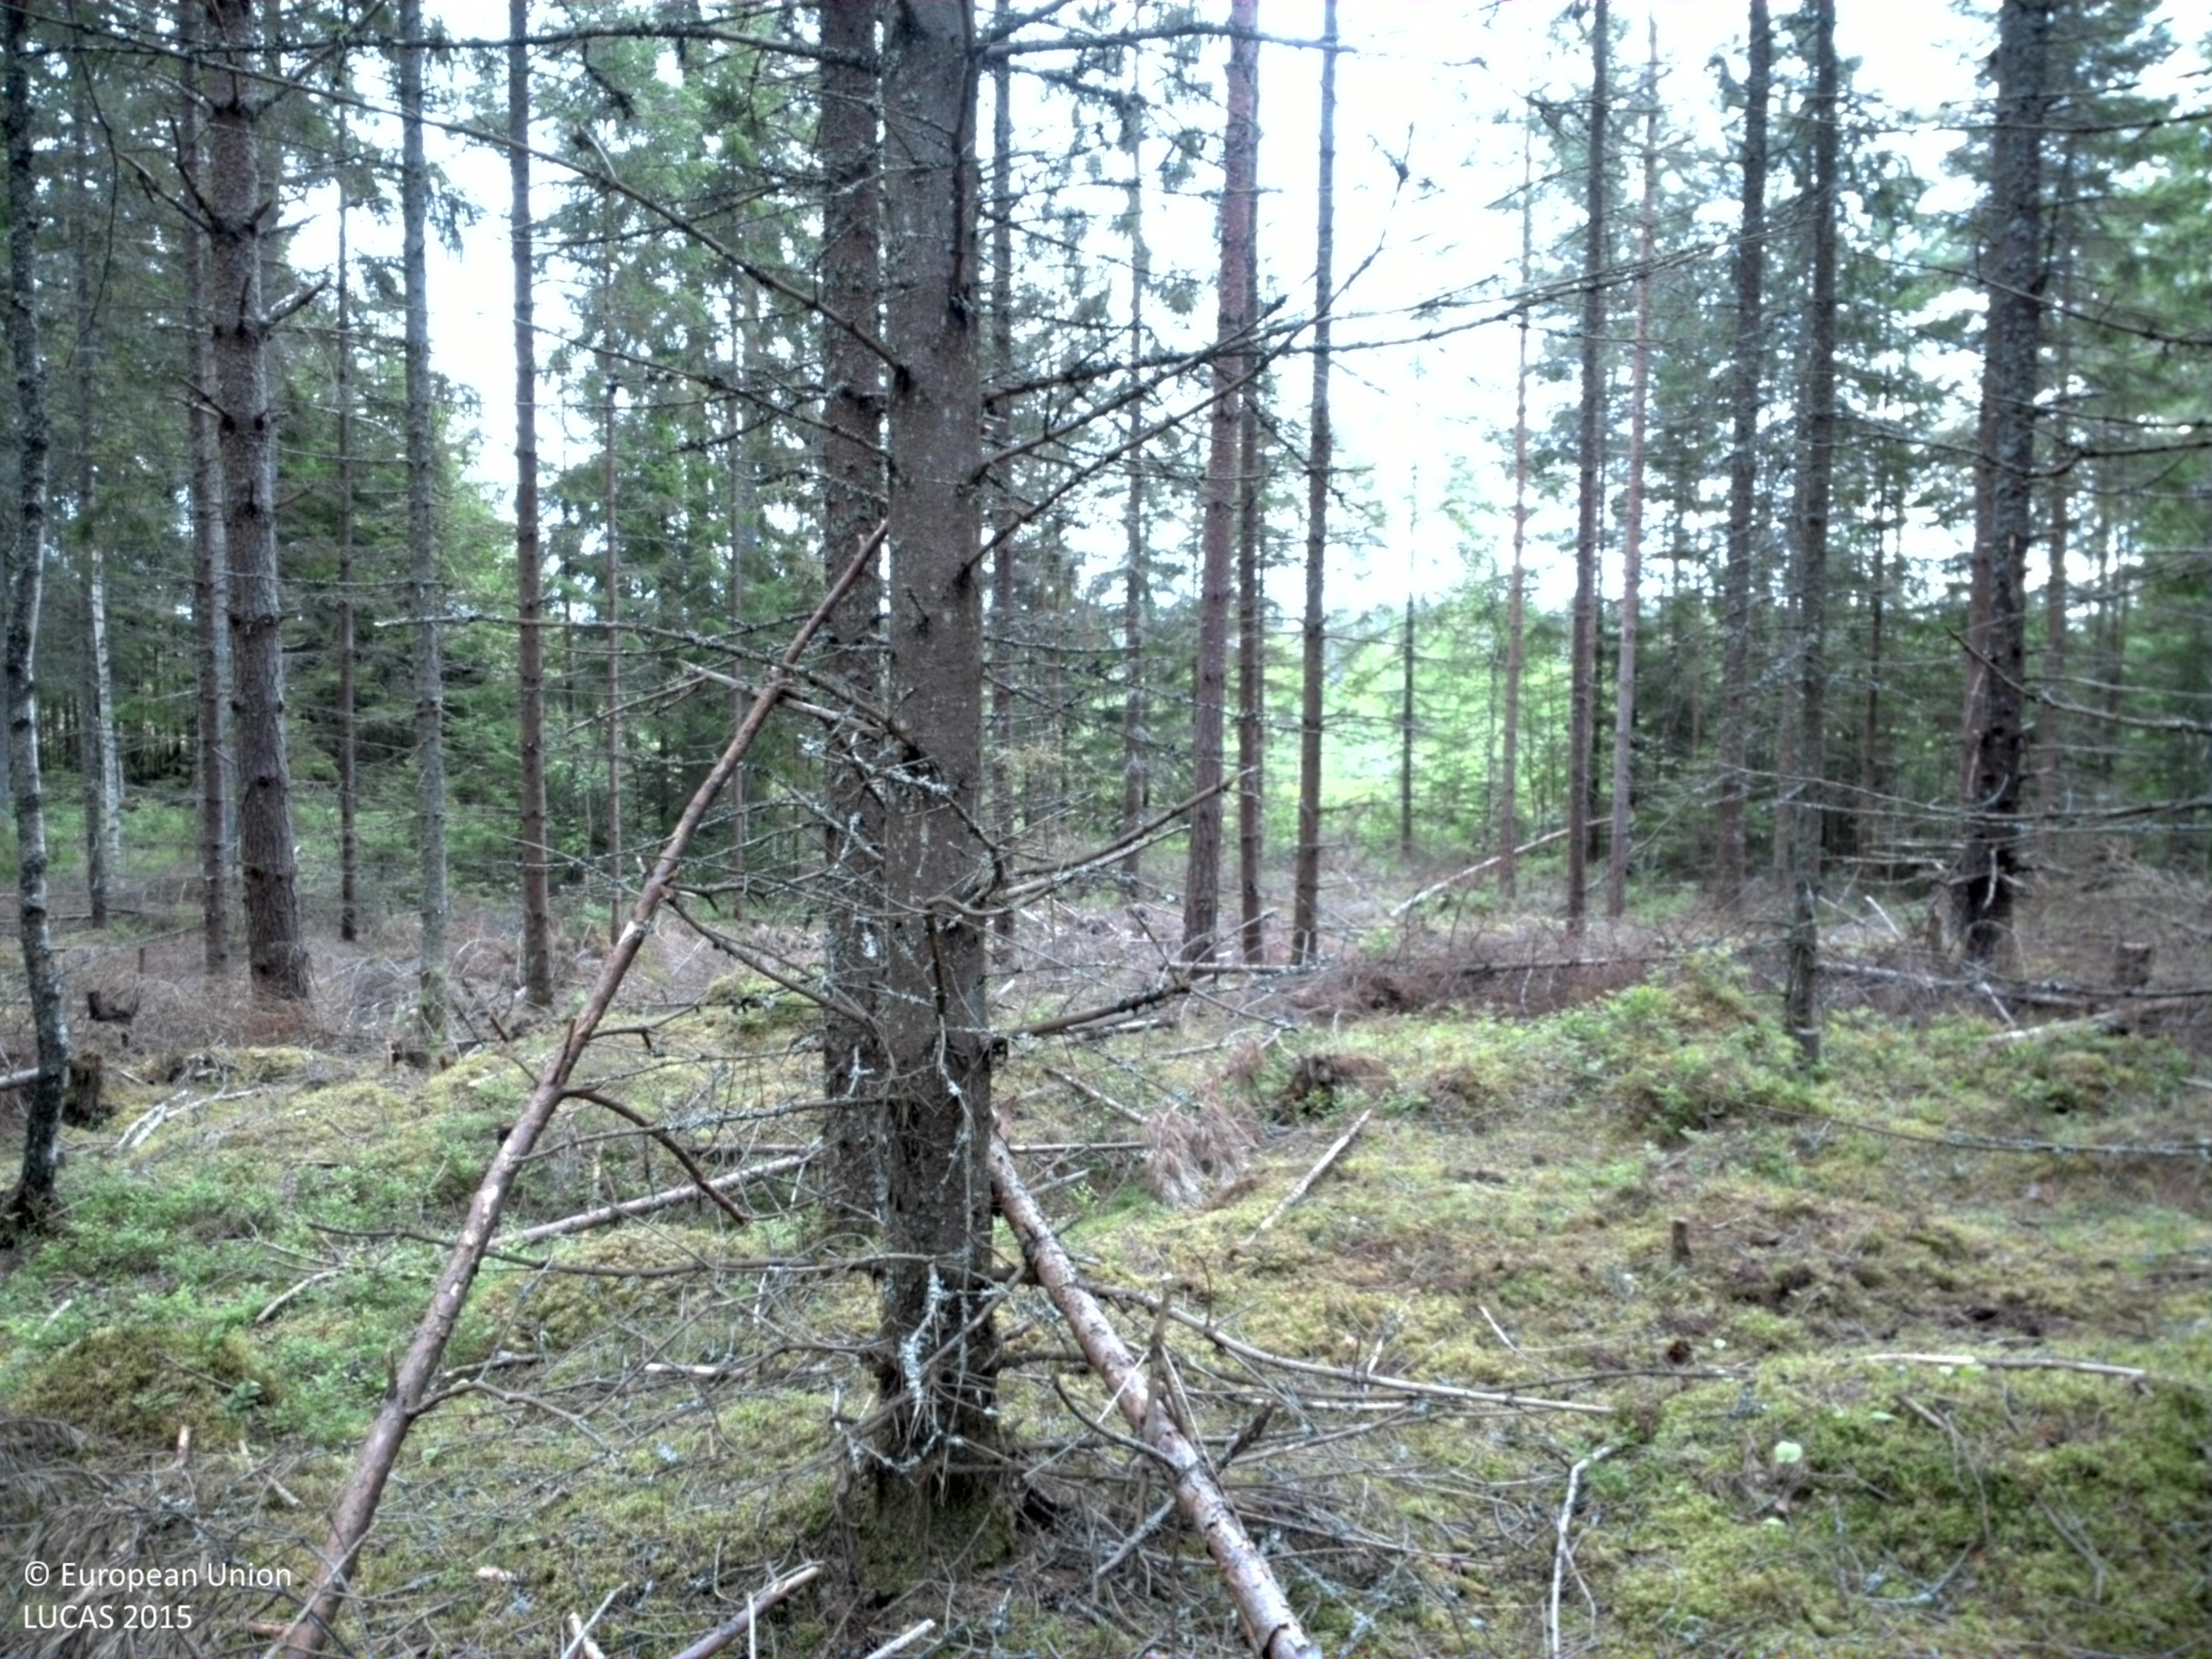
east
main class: Woodland
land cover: Spruce dominated coniferous woodland
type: boreal forest
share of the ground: 25 - 50 %
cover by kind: lichens and mosses 50 %, coniferous forest trees 45 %, herbaceous plants 5 %
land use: Forestry
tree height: > 5 m
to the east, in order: Spruce dominated coniferous woodland; Other coniferous woodland; Other mixed woodland; Ditches and canals; Other mixed woodland; Tracks; Other mixed woodland
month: July
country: SE
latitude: 58.9171
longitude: 14.5596
